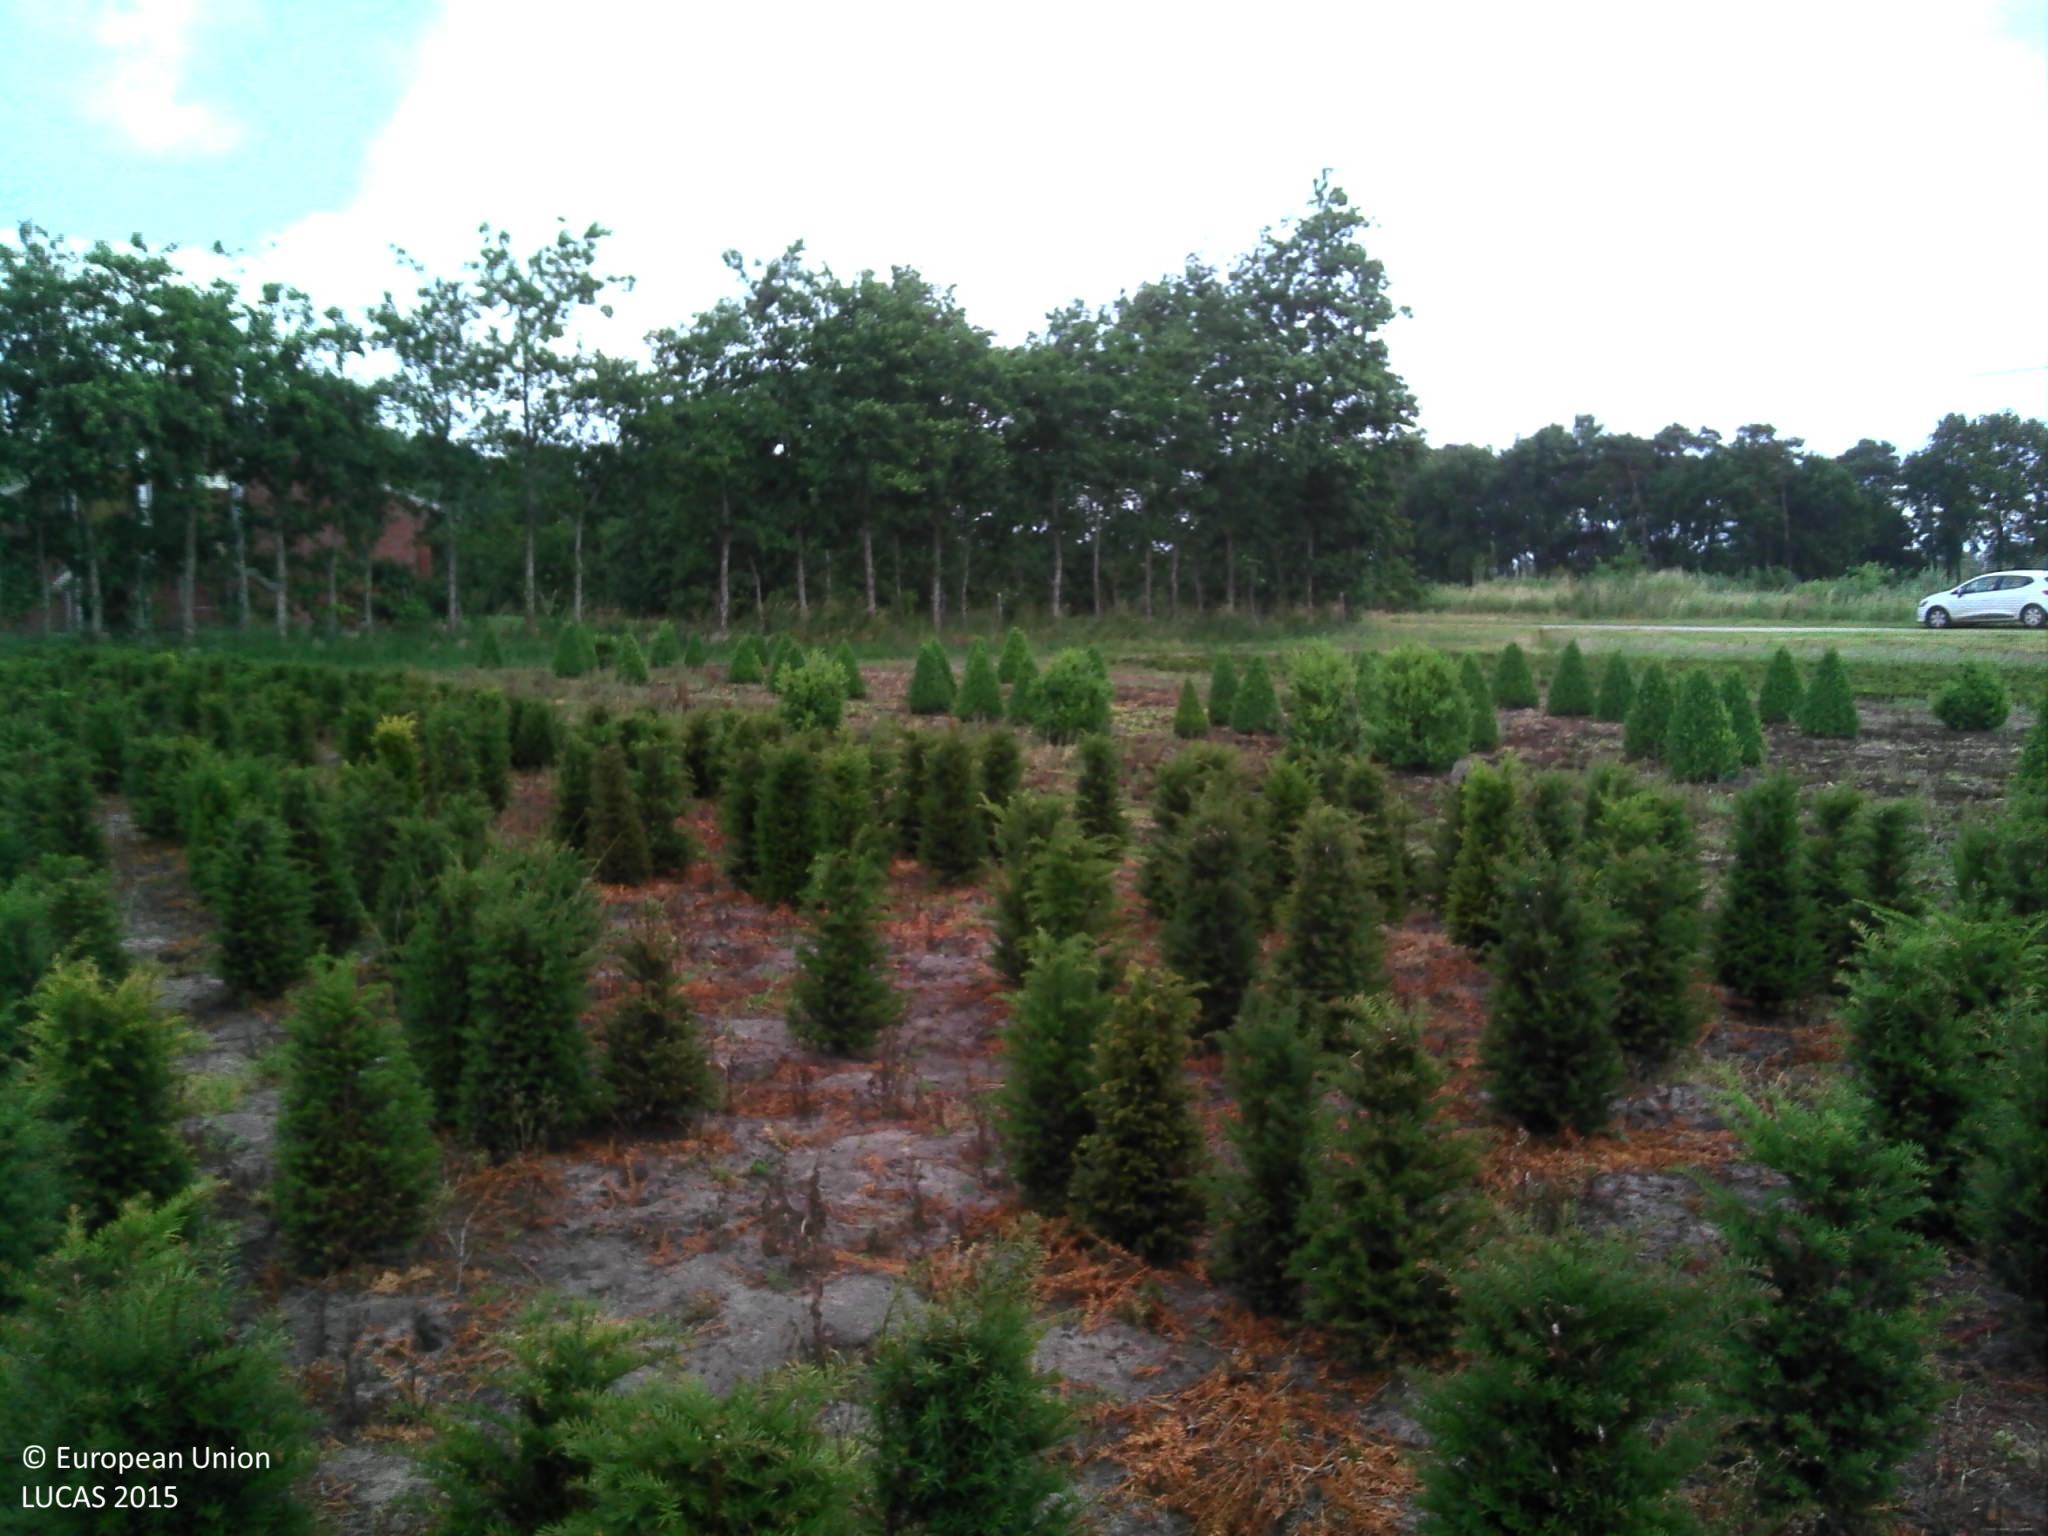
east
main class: Cropland
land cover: Nurseries
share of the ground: > 75 %
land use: Agriculture (excluding fallow land and kitchen gardens)
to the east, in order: Nurseries; Tracks; Nurseries; Tracks; Lines of trees; Ditches and canals; Grass margins; Electric lines; Grass margins; Paved roads, cycling and walking lanes; Spontaneously vegetated surfaces; Tracks; Fences; Maize
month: June
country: BE
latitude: 51.2101
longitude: 3.8814
